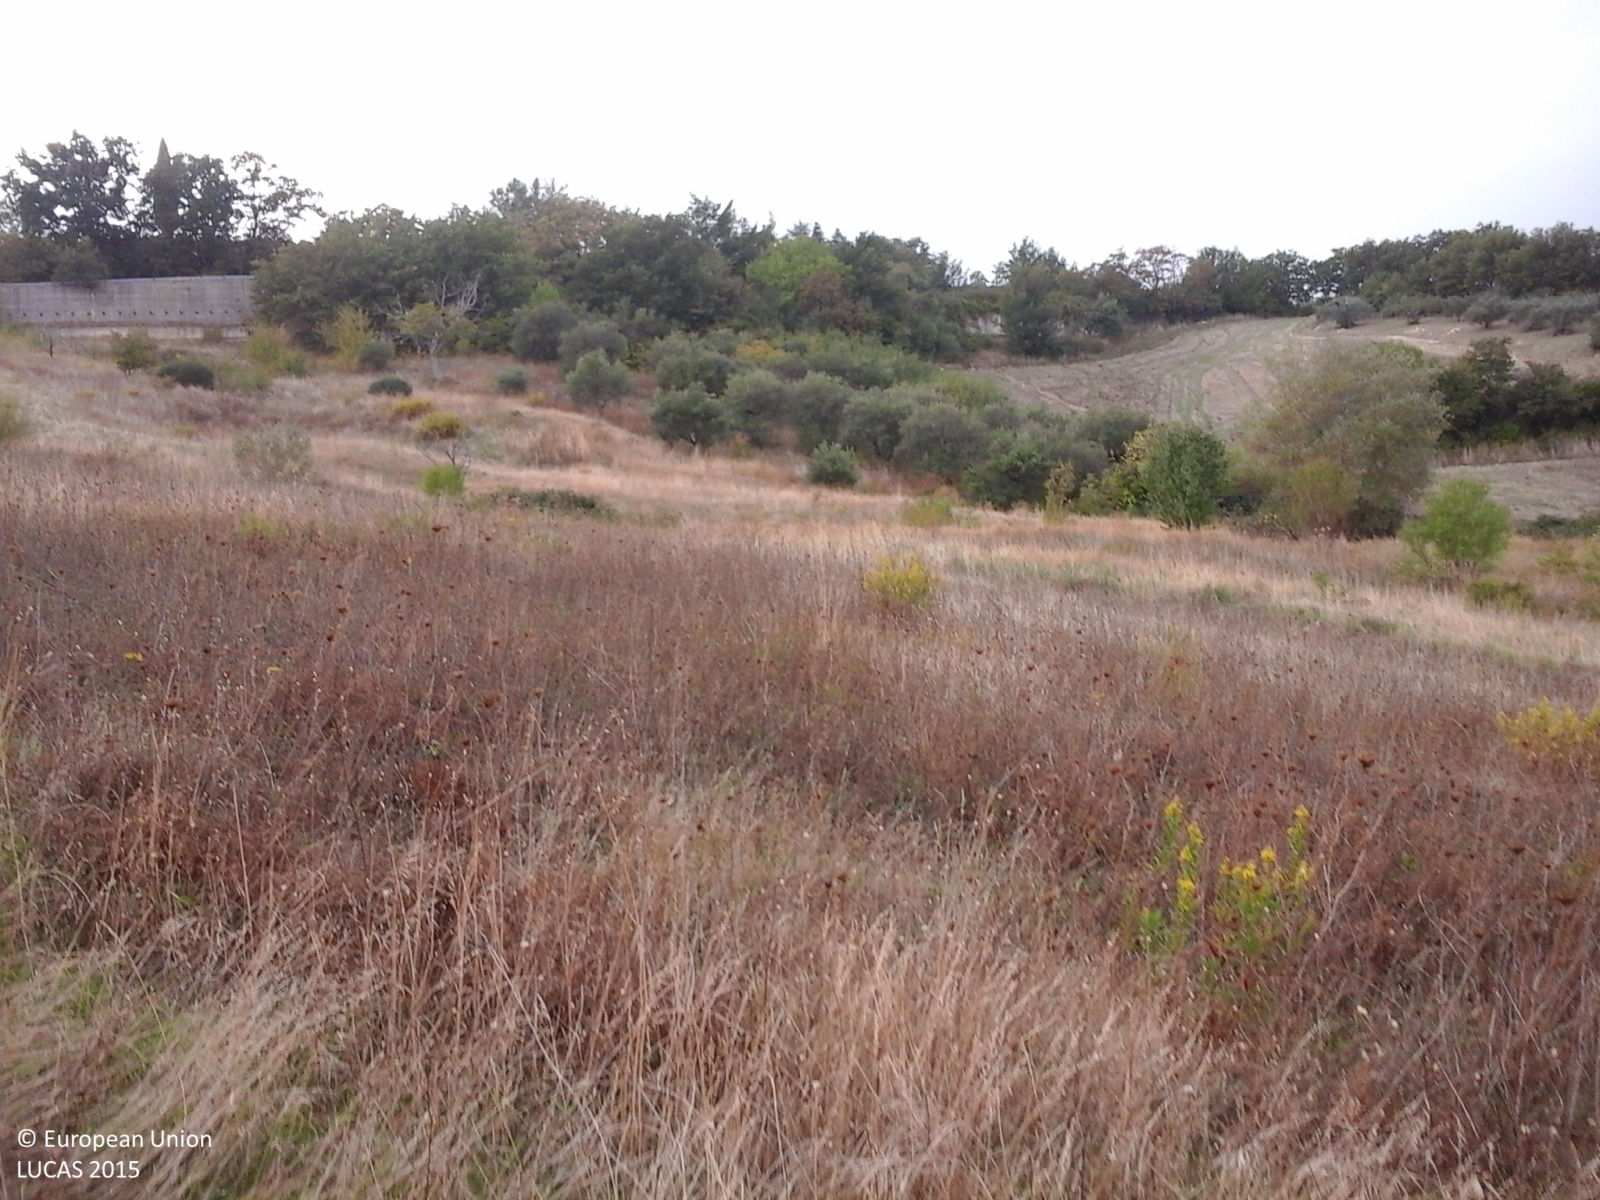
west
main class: Grassland
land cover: Spontaneously vegetated surfaces
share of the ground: > 75 %
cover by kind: herbaceous plants 100 %
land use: Fallow land
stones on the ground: < 10 %
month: October
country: IT
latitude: 41.5107
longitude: 15.1228
